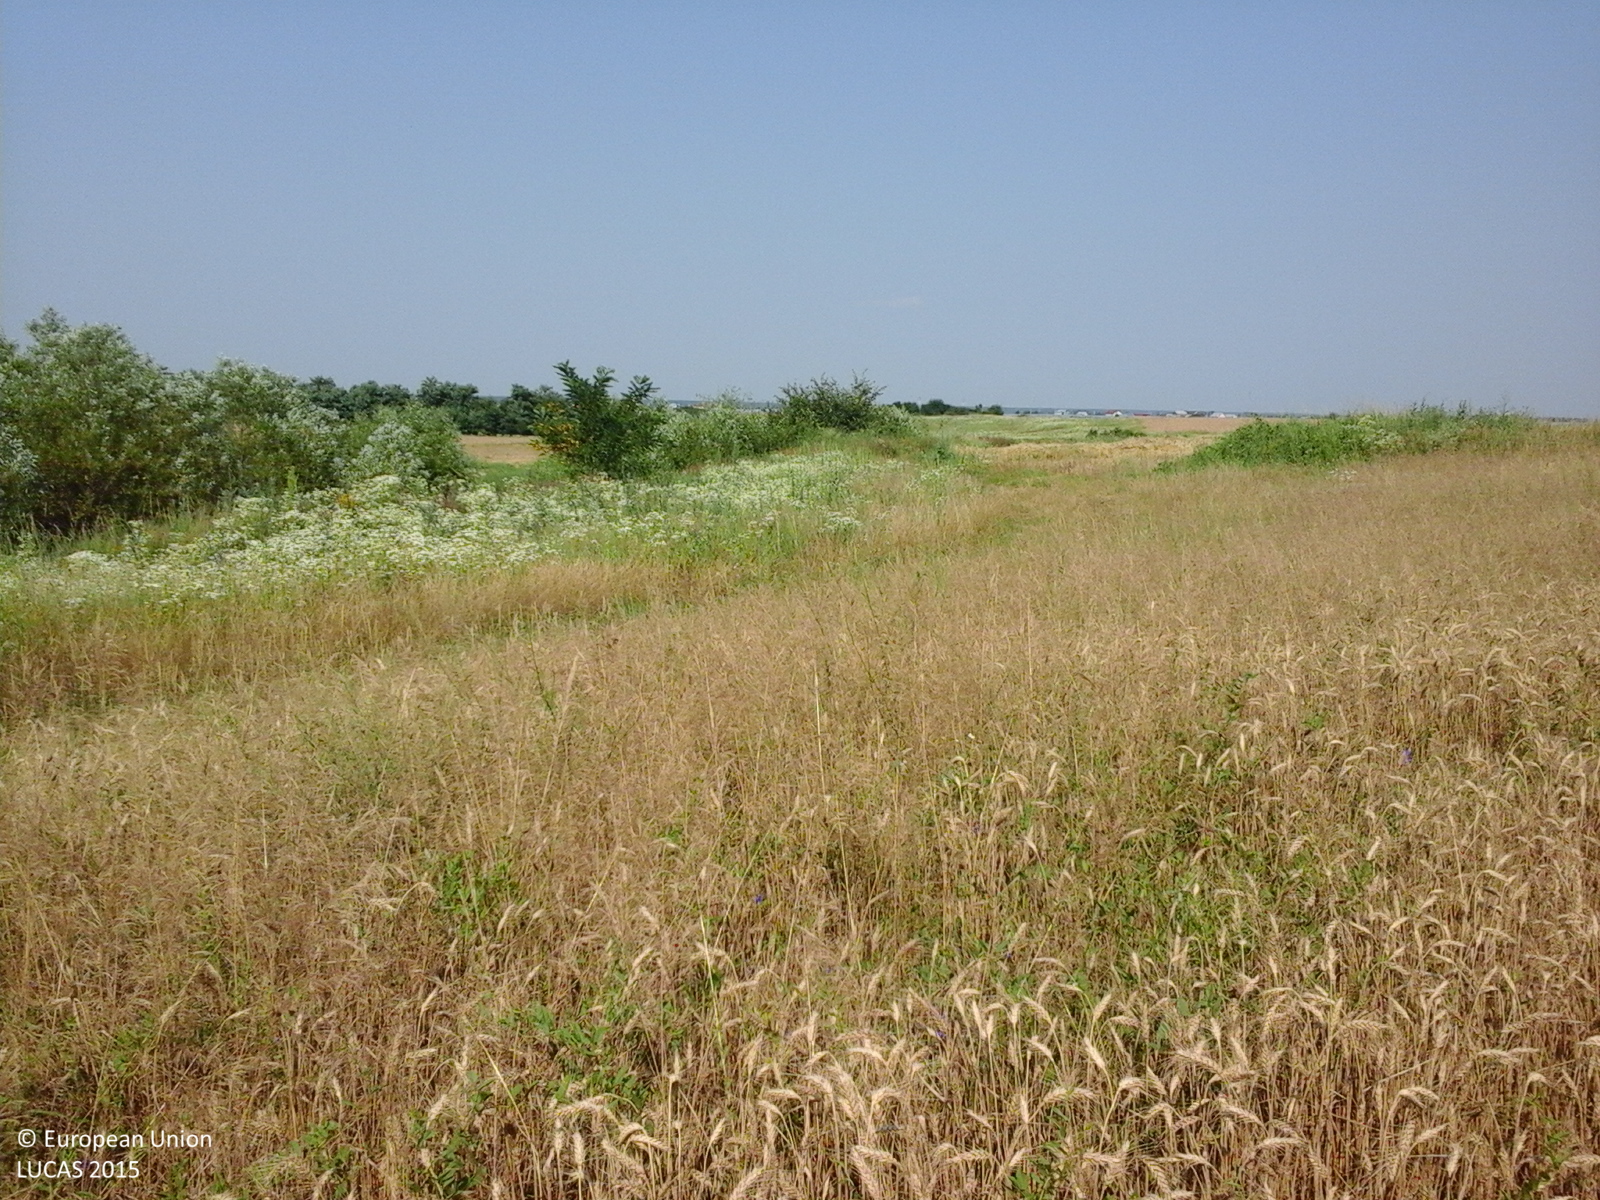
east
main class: Cropland
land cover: Common wheat
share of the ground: > 75 %
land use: Agriculture (excluding fallow land and kitchen gardens)
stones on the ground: < 10 %
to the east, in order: Common wheat; Spontaneously vegetated surfaces; Tracks; Spontaneously vegetated surfaces; Ditches and canals; Abandoned hedges; Spontaneously vegetated surfaces; Single bushes/trees; Common wheat
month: July
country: RO
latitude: 44.8285
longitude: 25.6169
